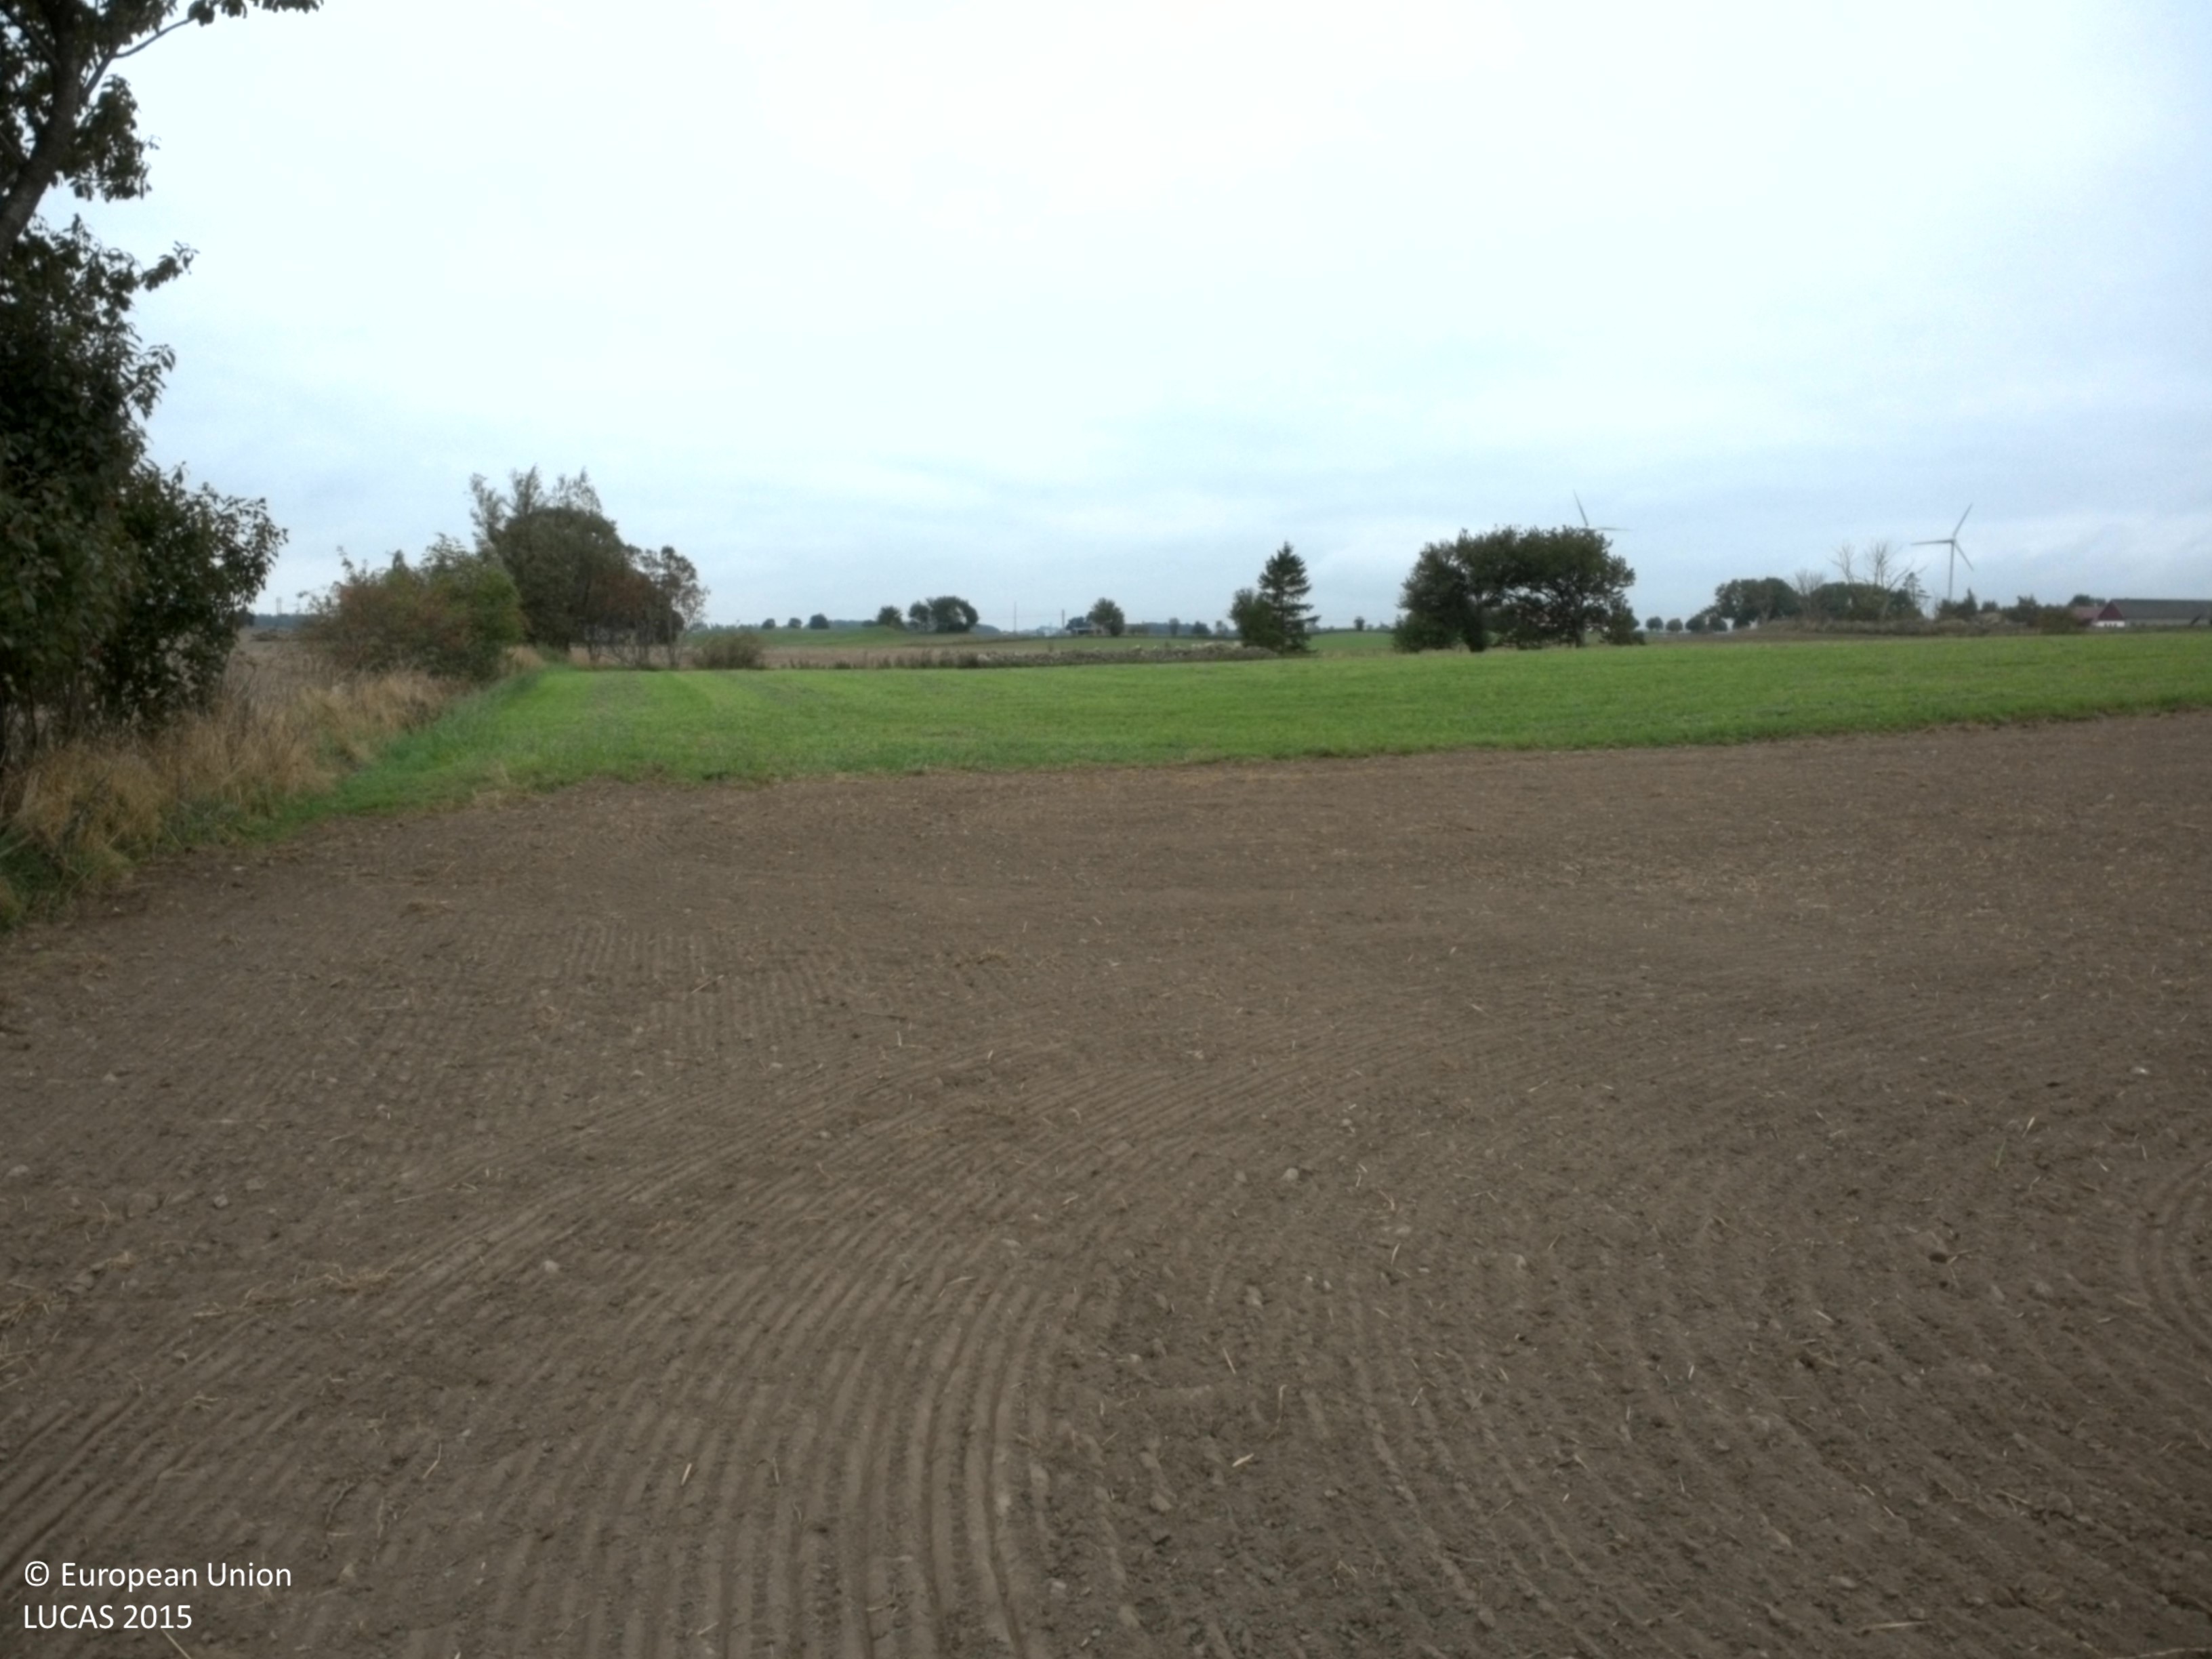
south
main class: Cropland
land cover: Common wheat
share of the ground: < 10 %
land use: Agriculture (excluding fallow land and kitchen gardens)
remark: Tilled/Sowed
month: October
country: SE
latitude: 55.5662
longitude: 14.0421
